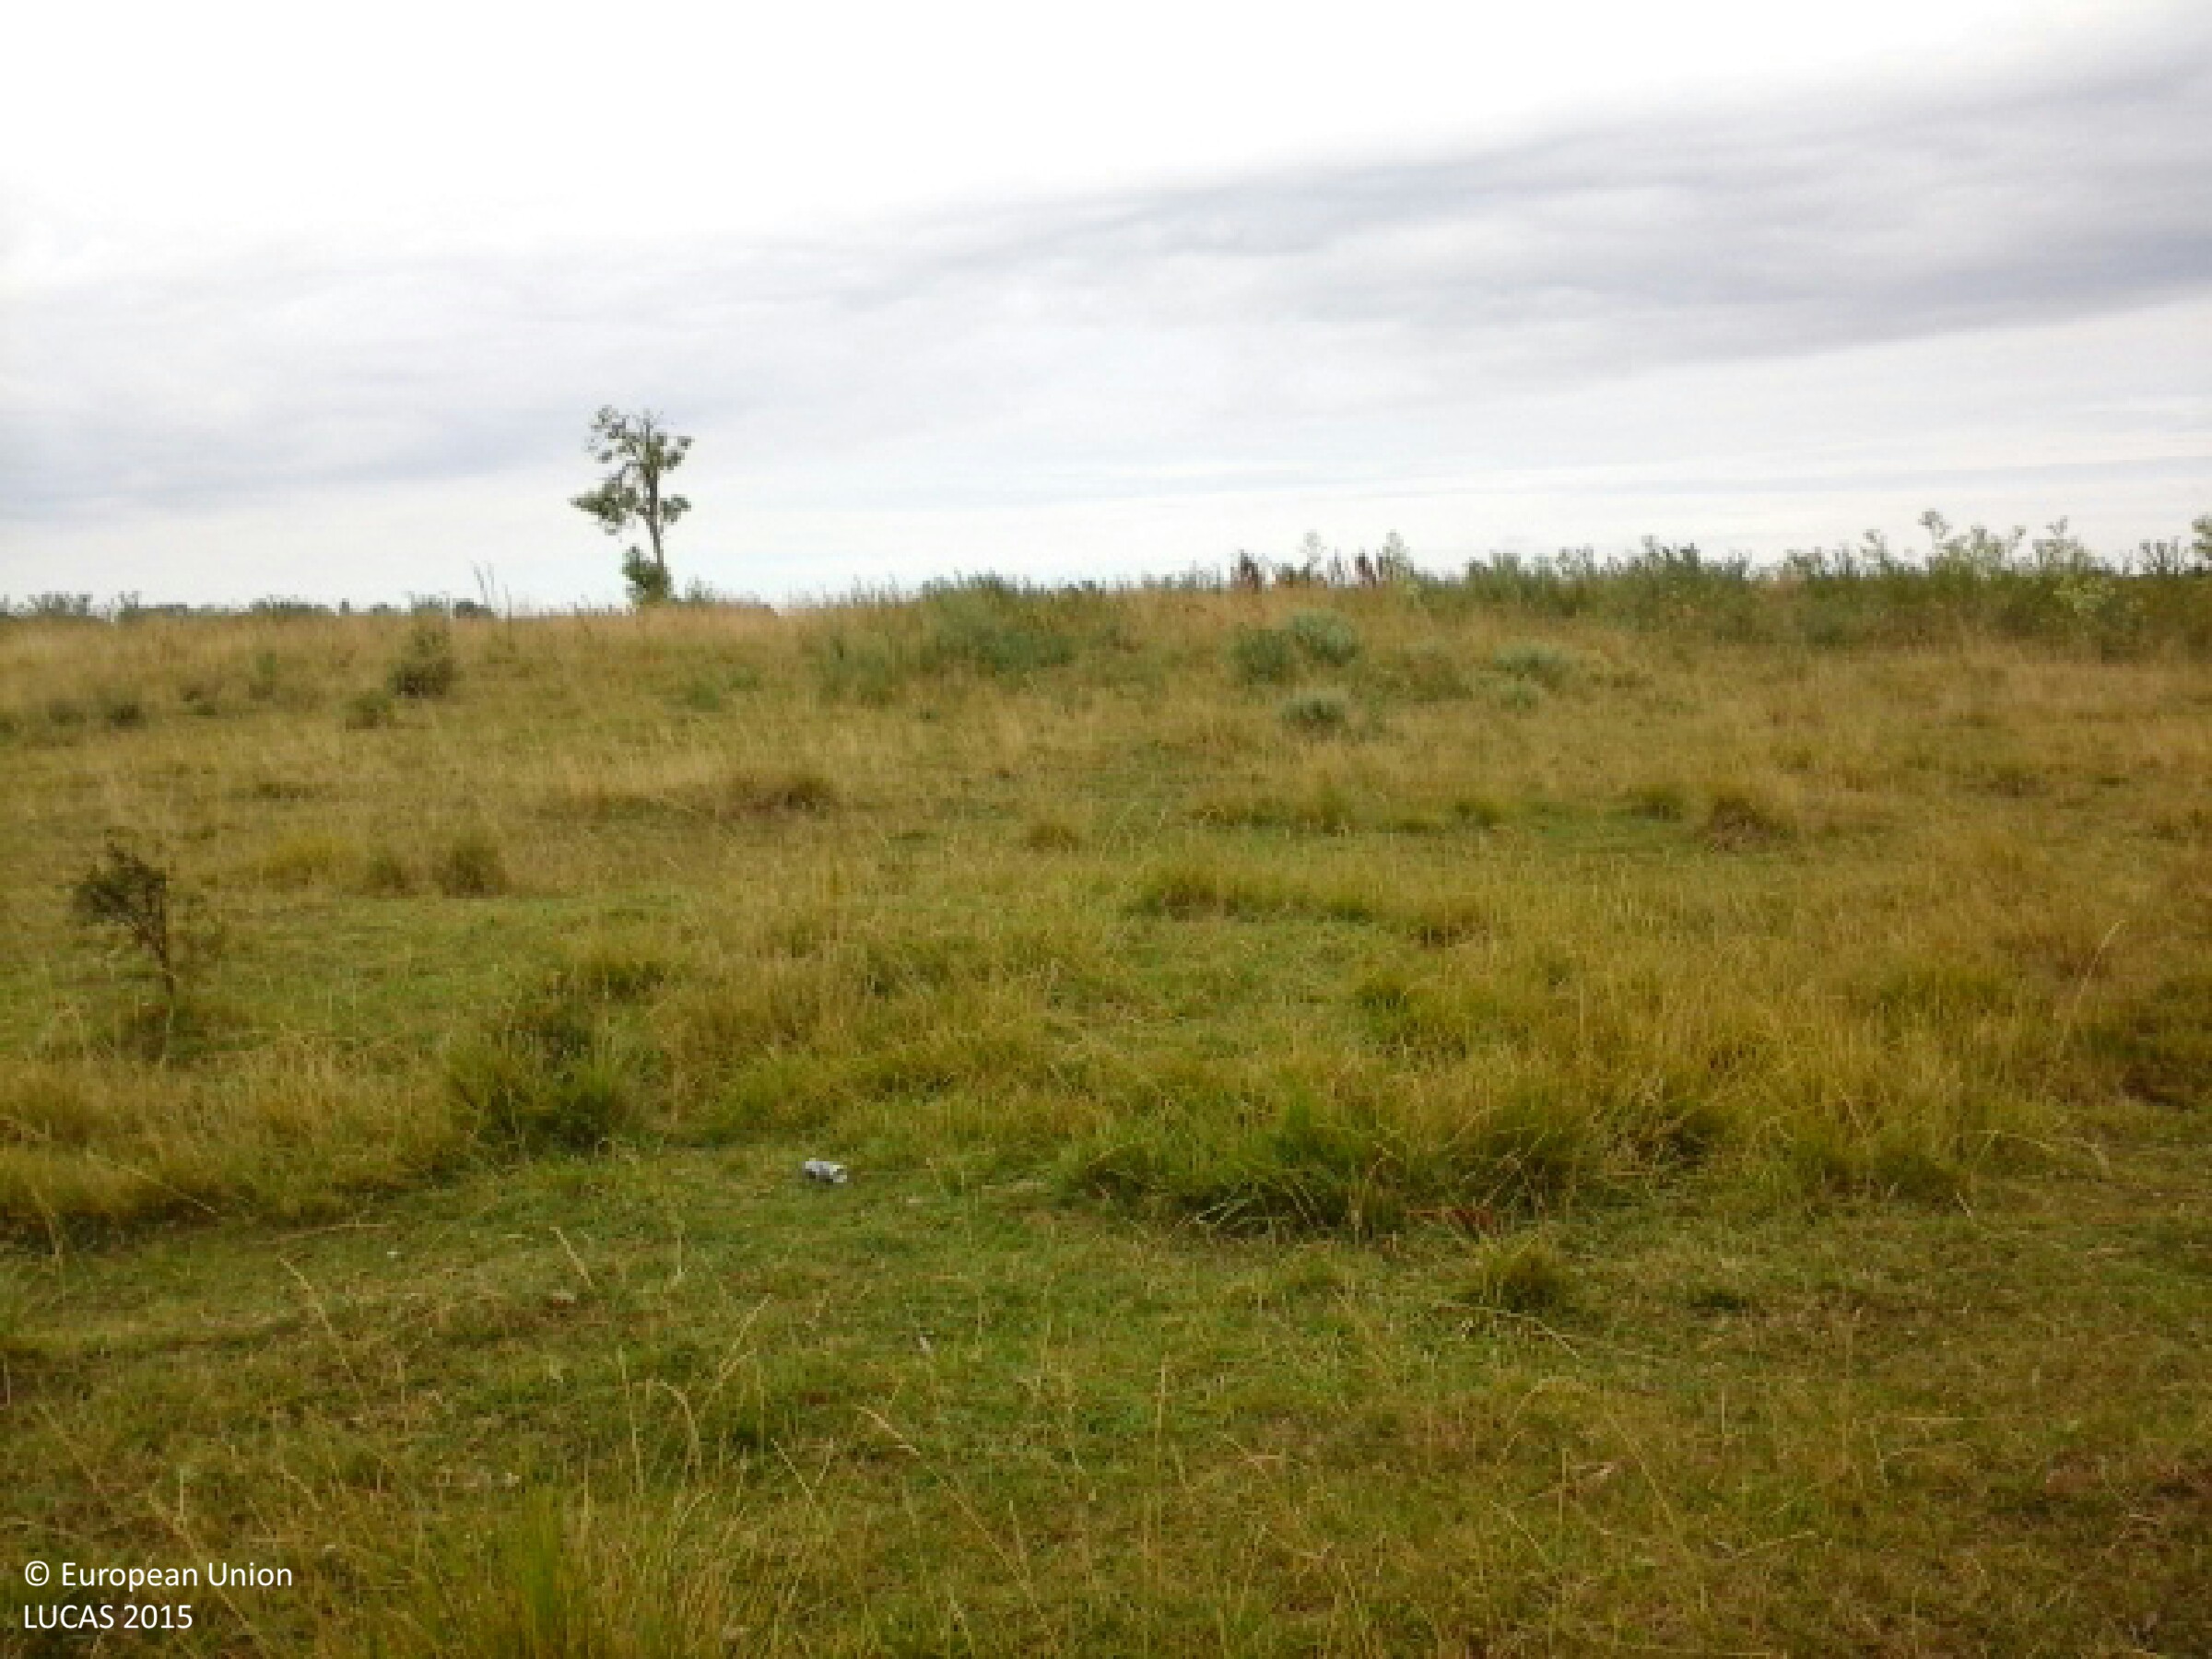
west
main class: Grassland
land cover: Grassland without tree/shrub cover
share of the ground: > 75 %
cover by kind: herbaceous plants 100 %
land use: Agriculture (excluding fallow land and kitchen gardens)
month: June
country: HU
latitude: 48.0595
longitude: 21.4636
